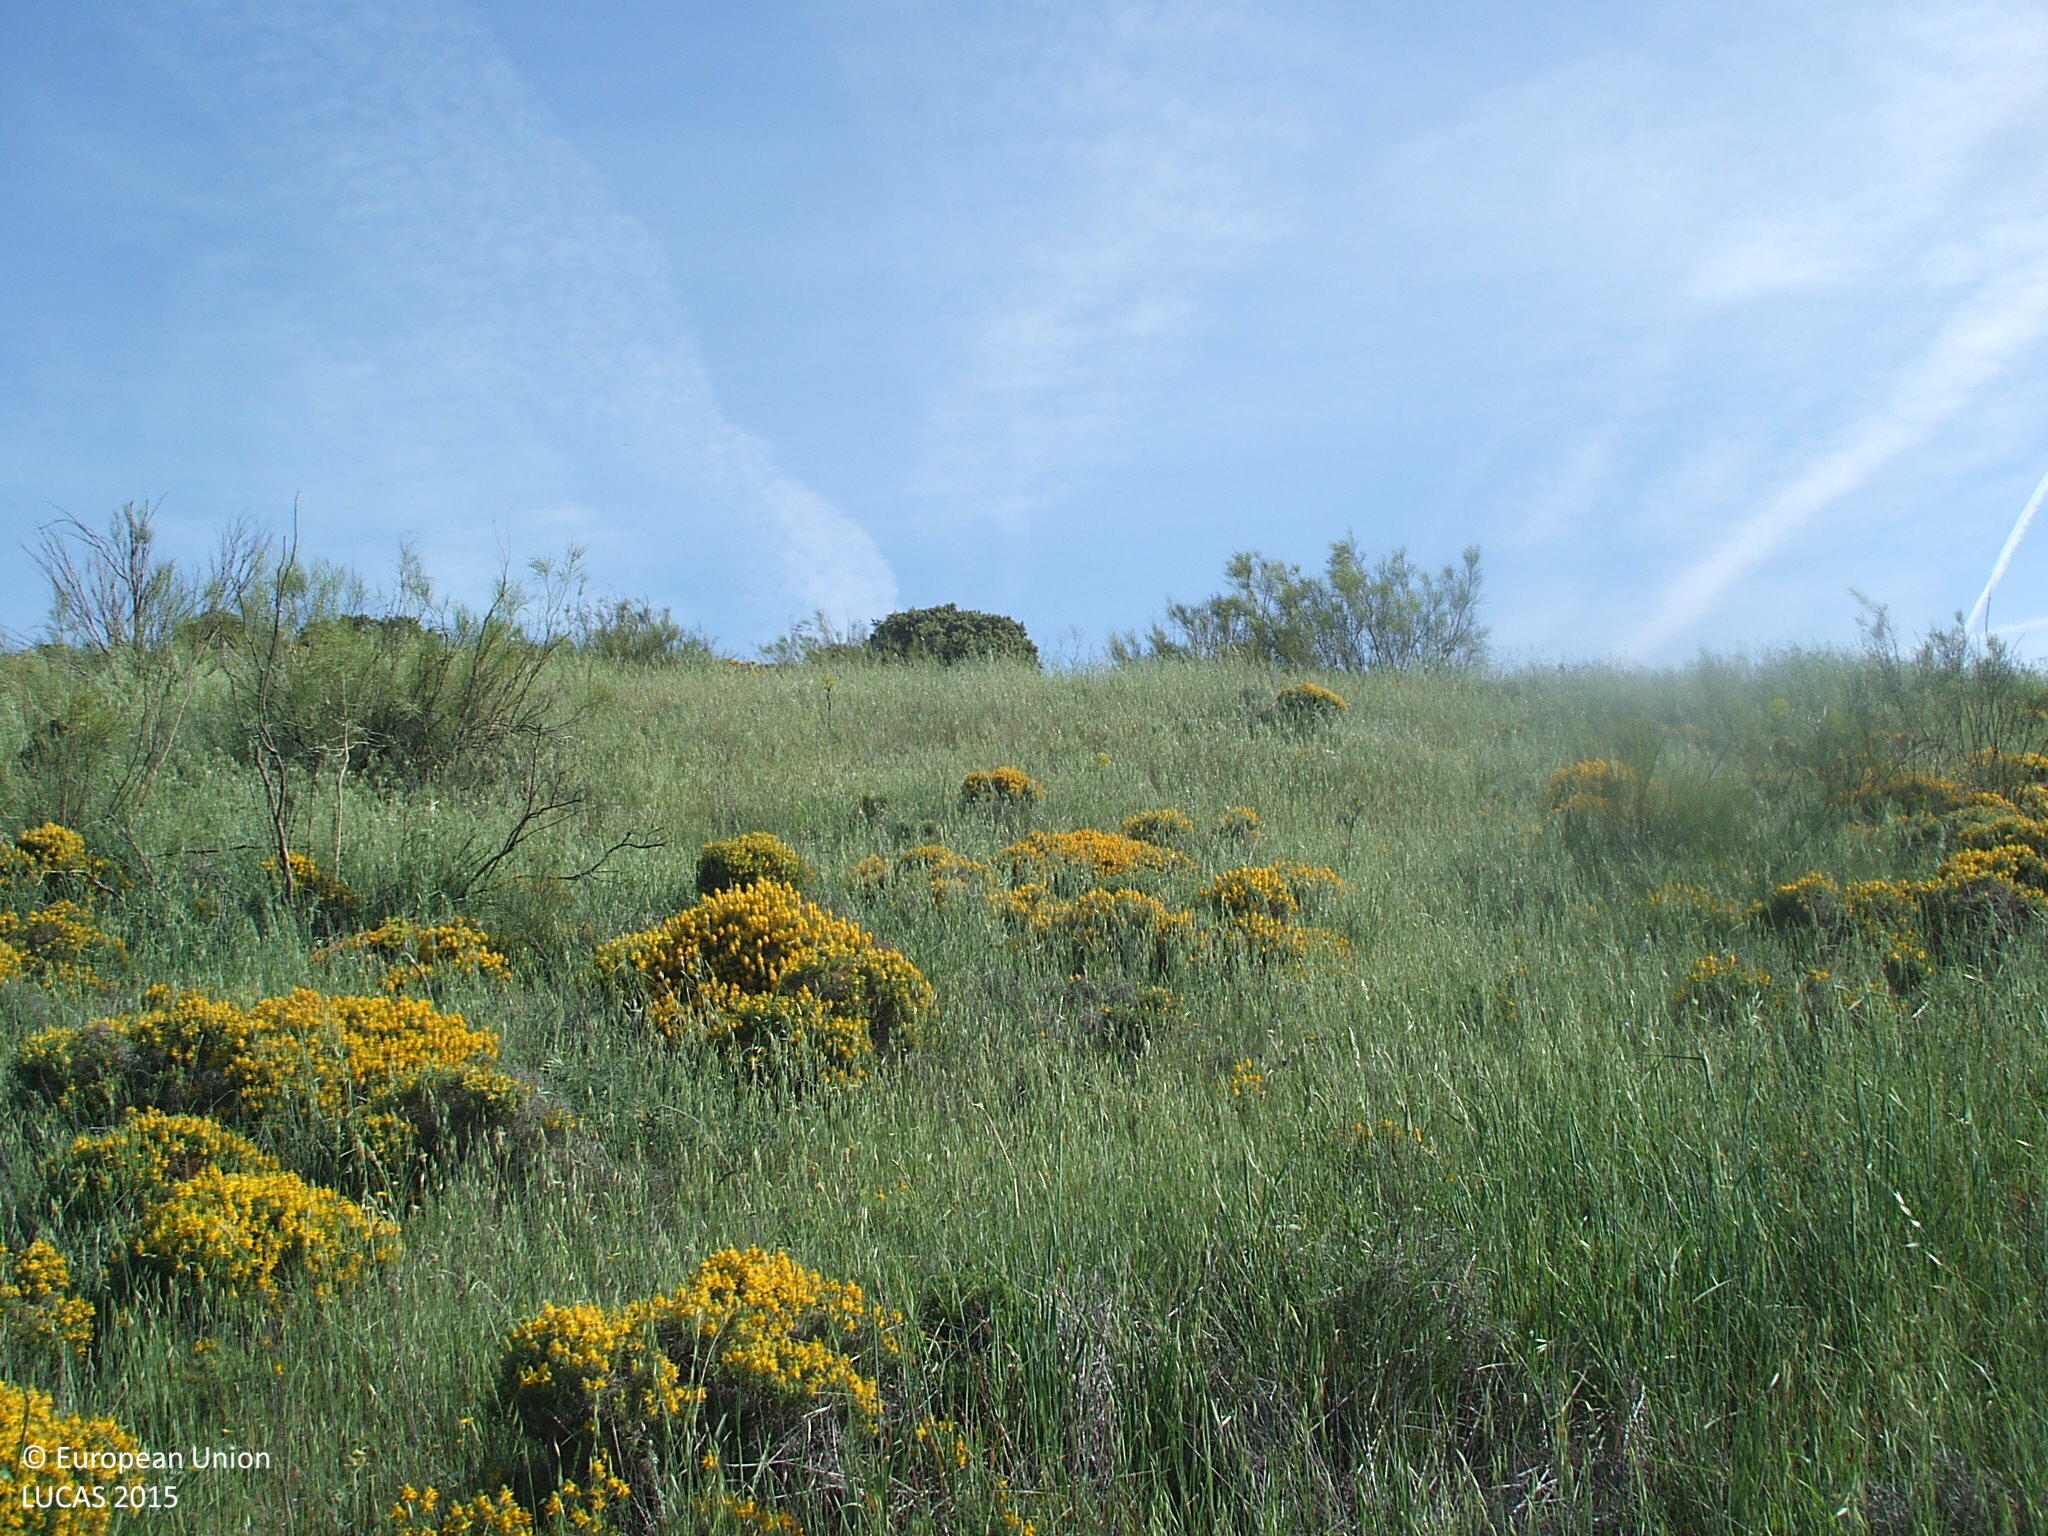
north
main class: Shrubland
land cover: Shrubland without tree cover
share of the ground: 50 - 75 %
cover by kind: shrubs 60 %, herbaceous plants 40 %
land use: Semi-natural and natural areas not in use
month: May
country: ES
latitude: 40.7112
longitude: -3.3053
